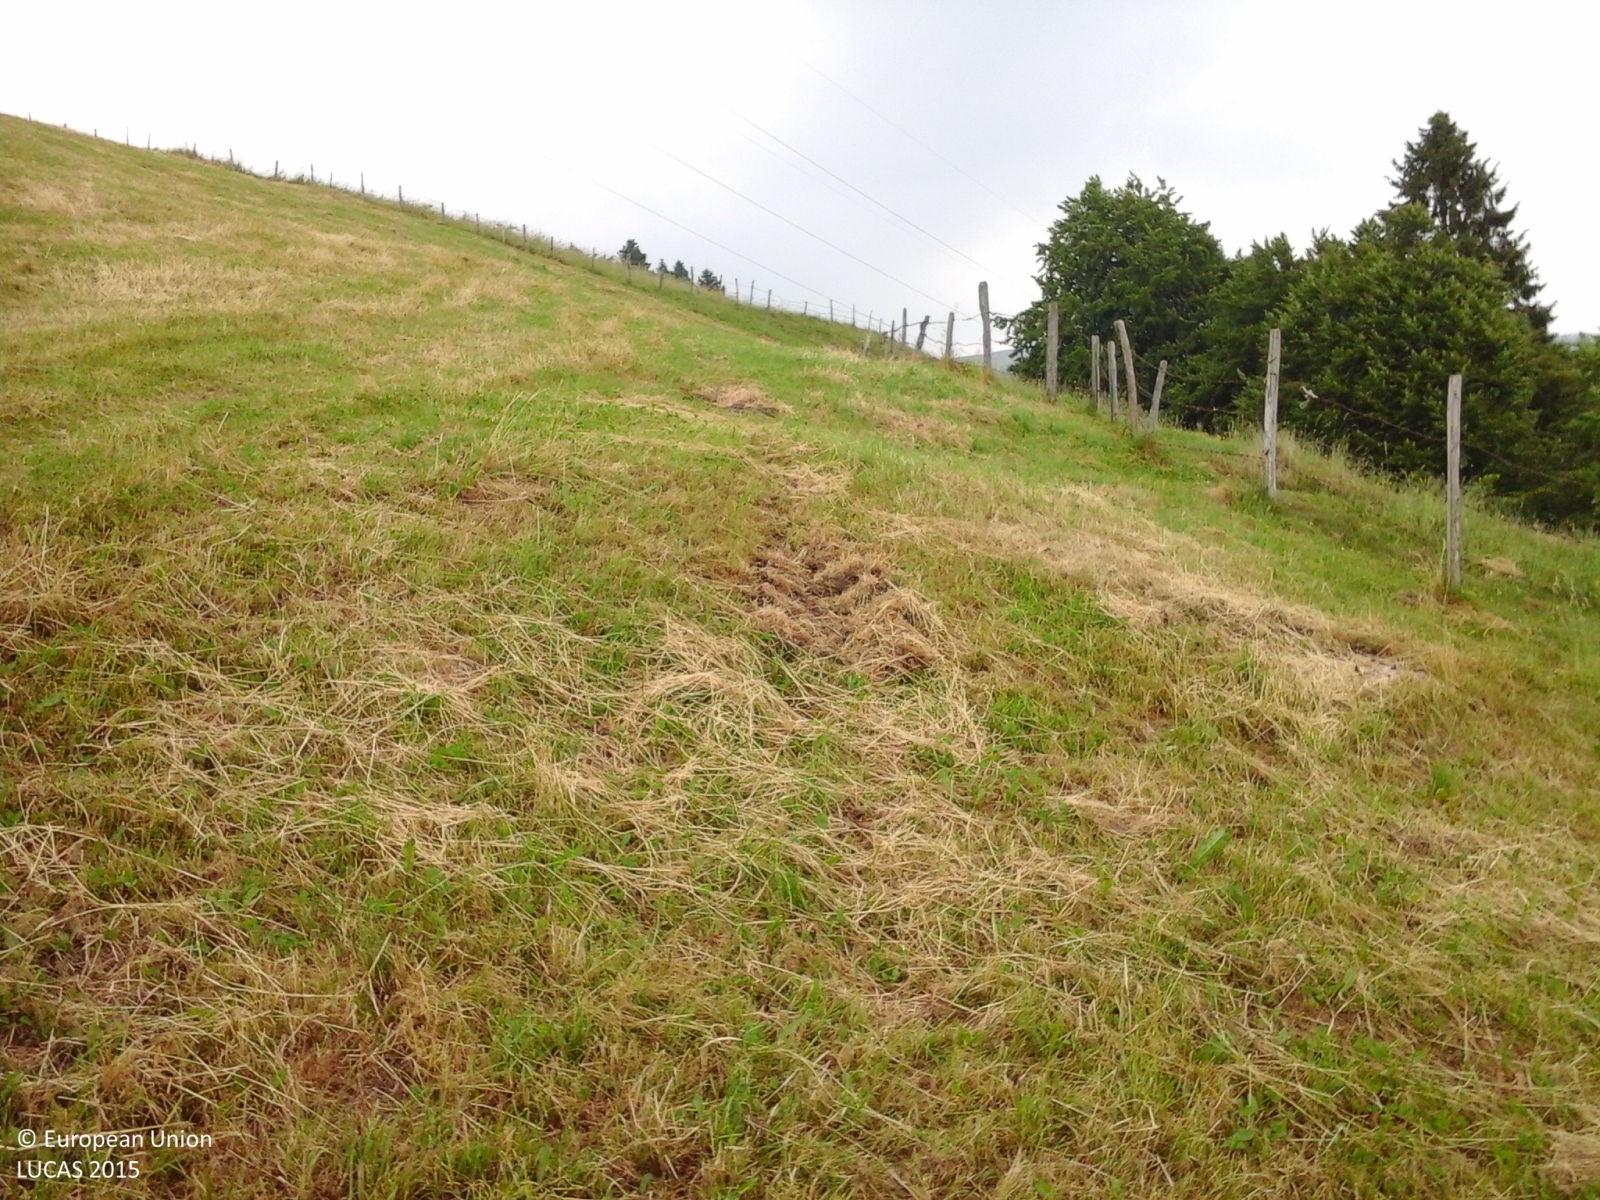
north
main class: Grassland
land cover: Grassland without tree/shrub cover
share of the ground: > 75 %
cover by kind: herbaceous plants 100 %
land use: Agriculture (excluding fallow land and kitchen gardens)
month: June
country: IT
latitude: 45.8166
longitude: 11.6064
